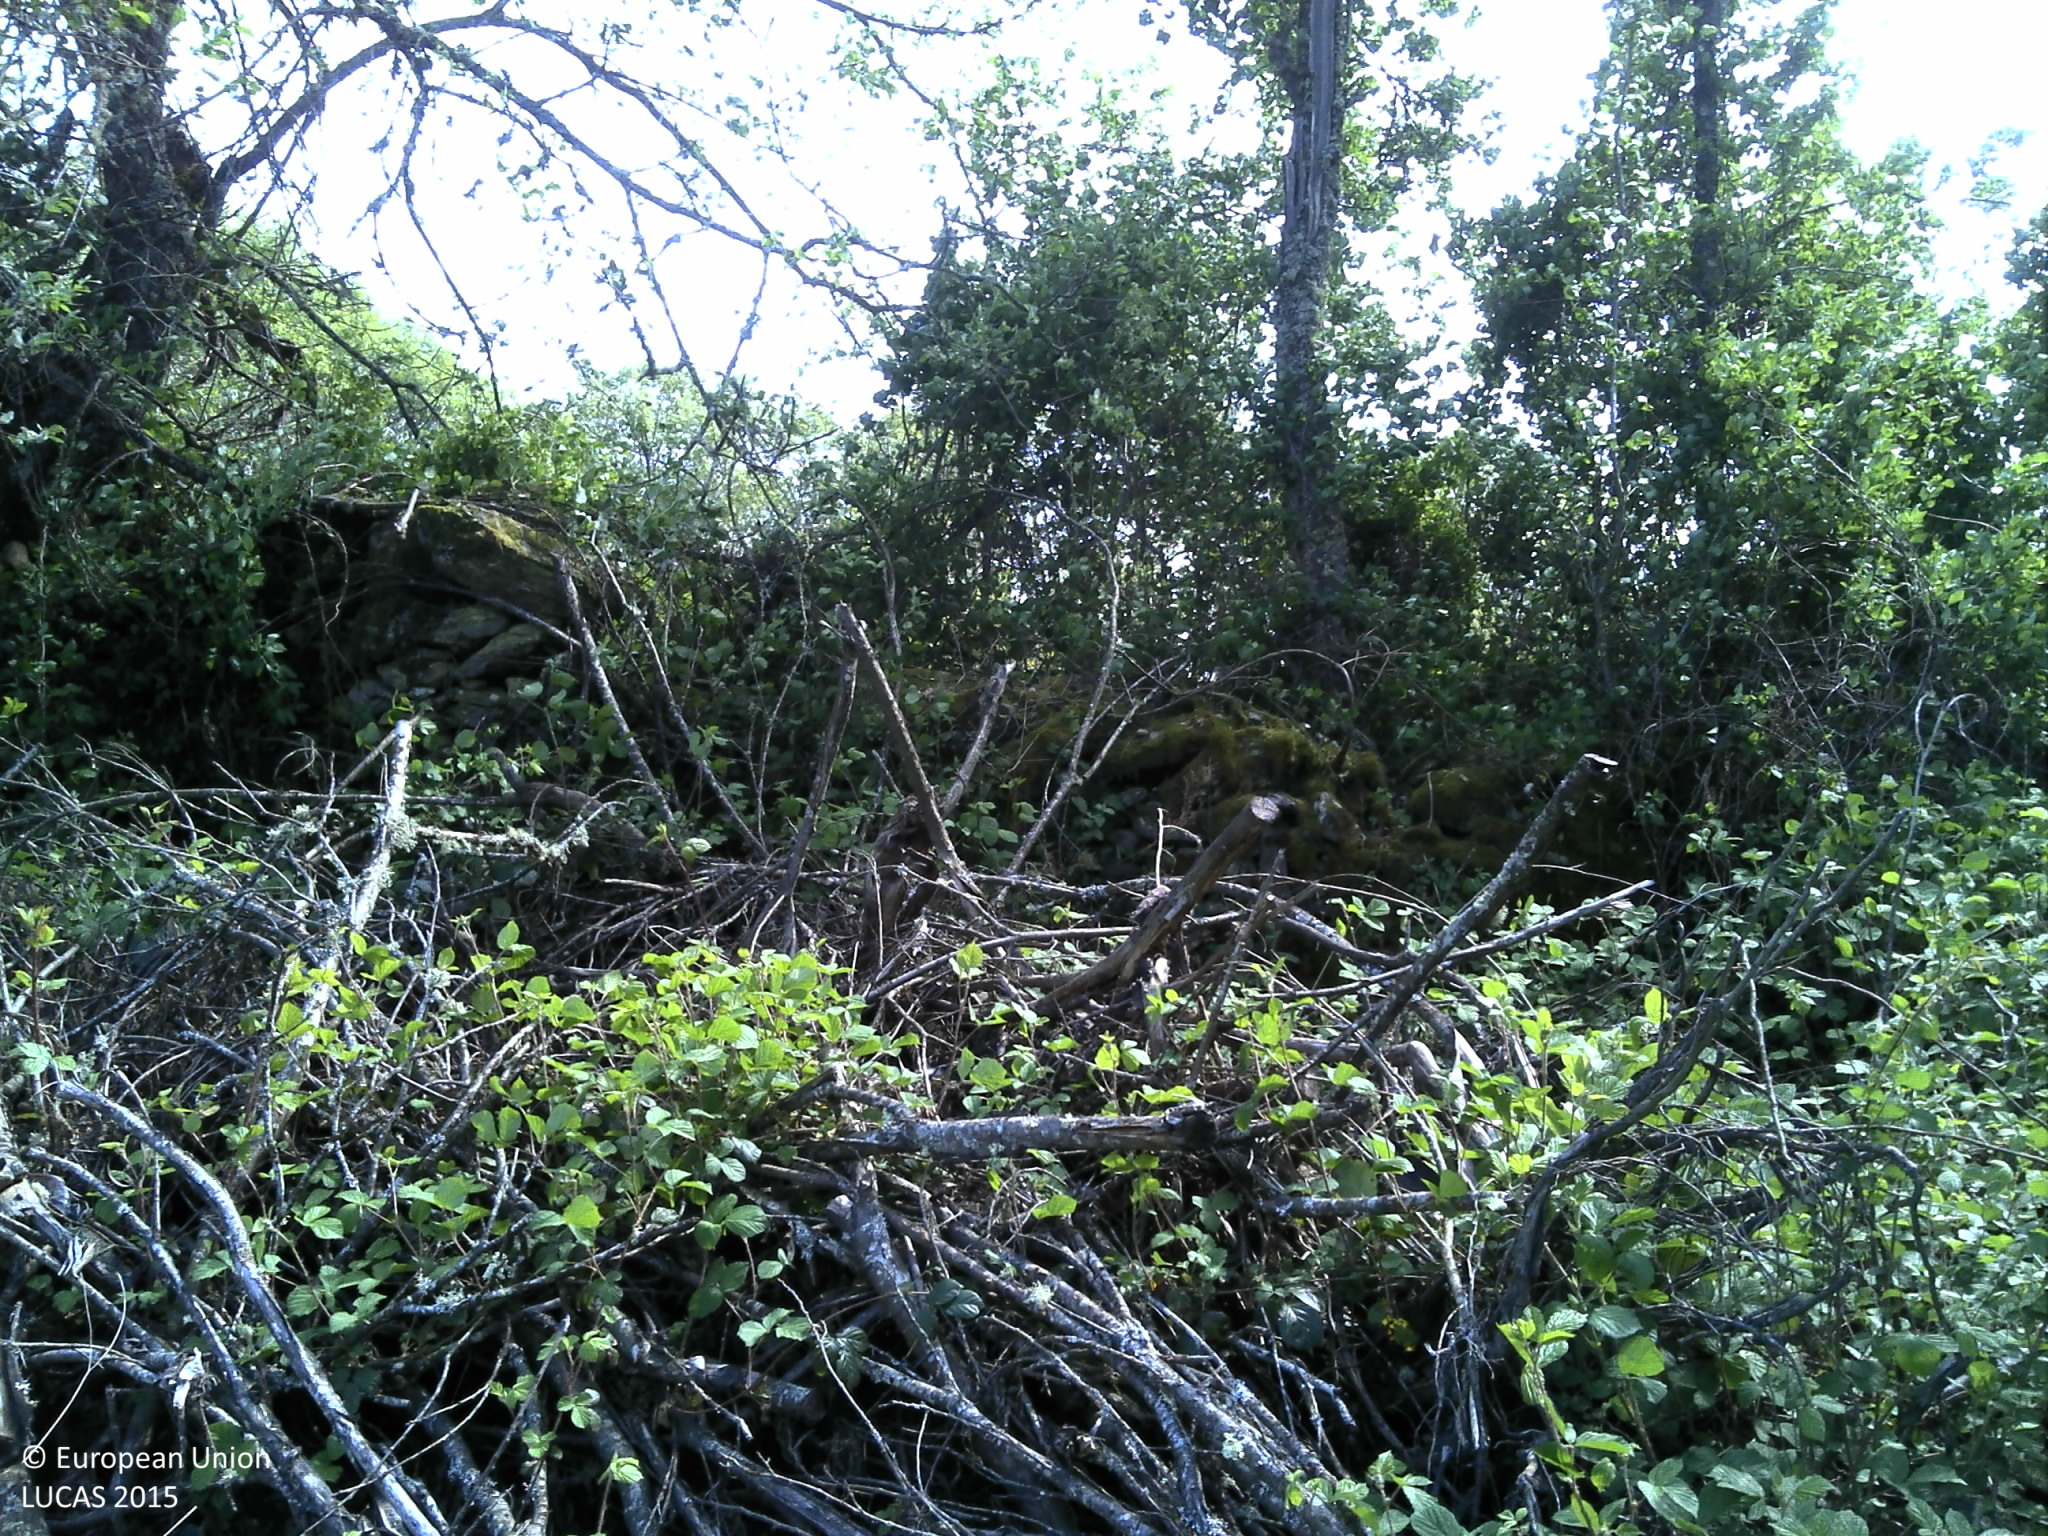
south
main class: Shrubland
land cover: Shrubland with sparse tree cover
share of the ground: 50 - 75 %
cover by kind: shrubs 75 %, herbaceous plants 20 %, broadleaved forest trees 5 %
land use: Semi-natural and natural areas not in use
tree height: > 5 m
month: May
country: PT
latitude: 41.5327
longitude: -7.5438
